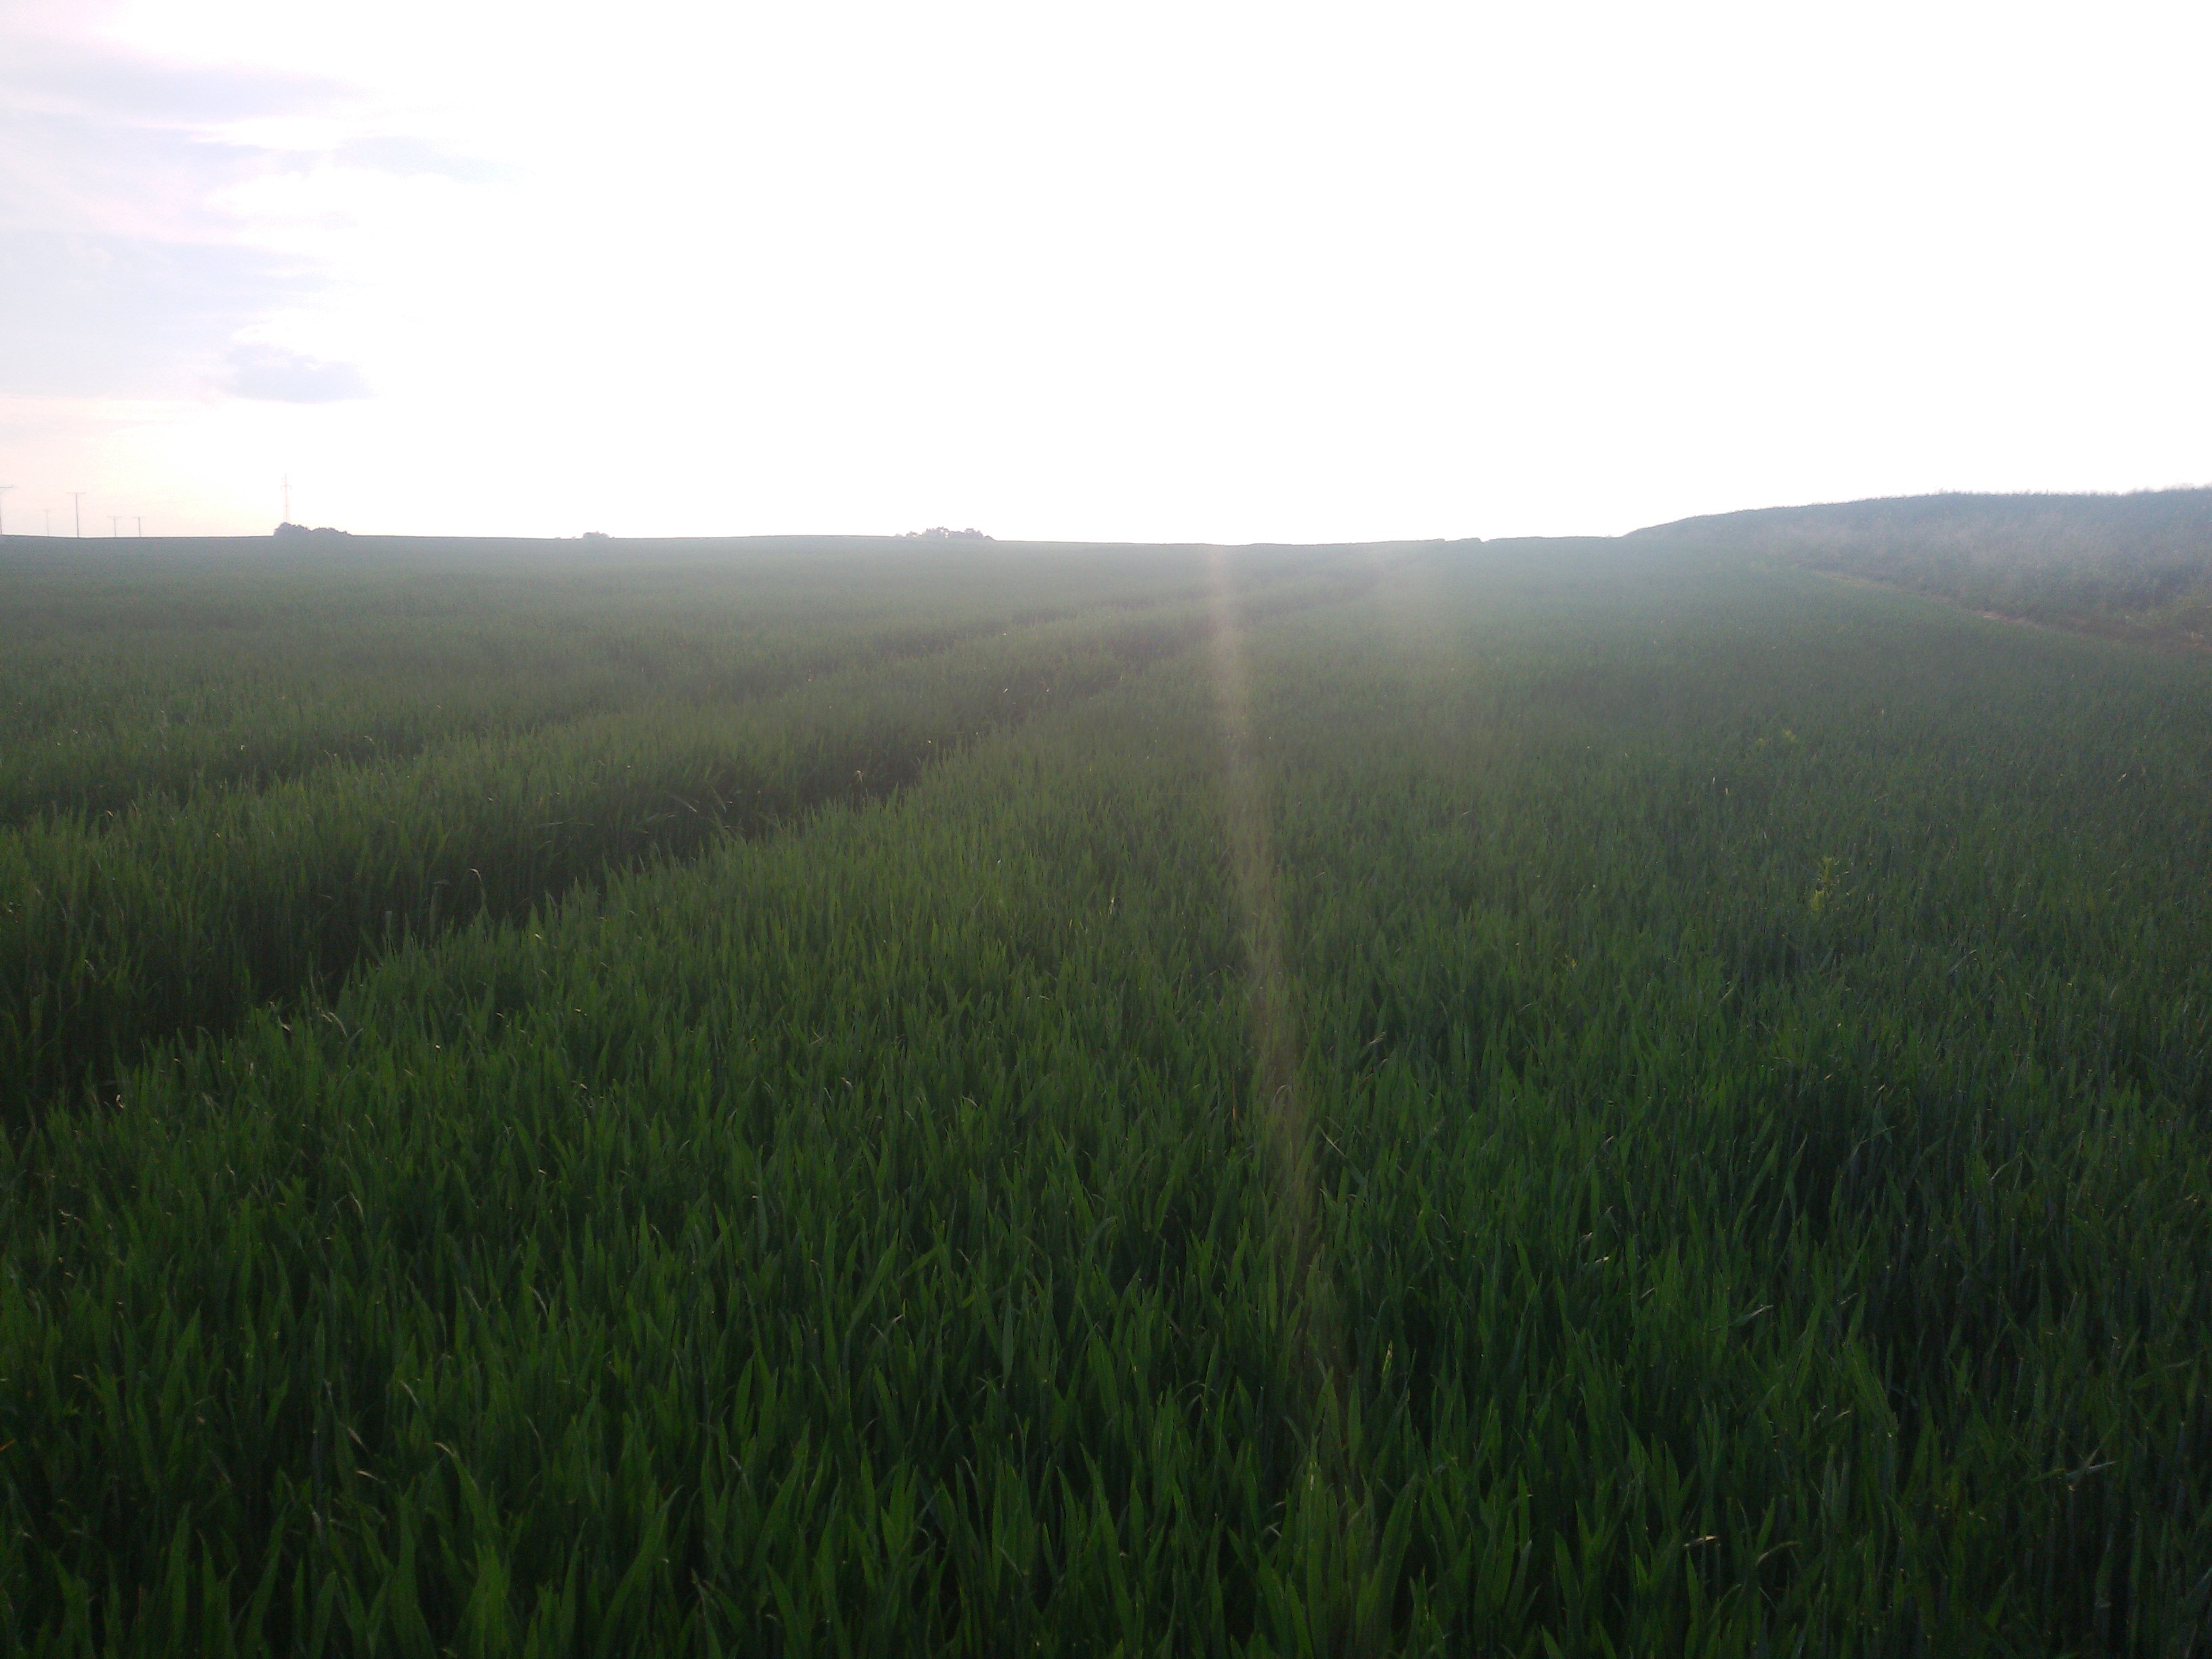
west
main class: Cropland
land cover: Common wheat
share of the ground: > 75 %
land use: Agriculture (excluding fallow land and kitchen gardens)
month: May
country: PL
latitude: 50.5490
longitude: 17.2513
